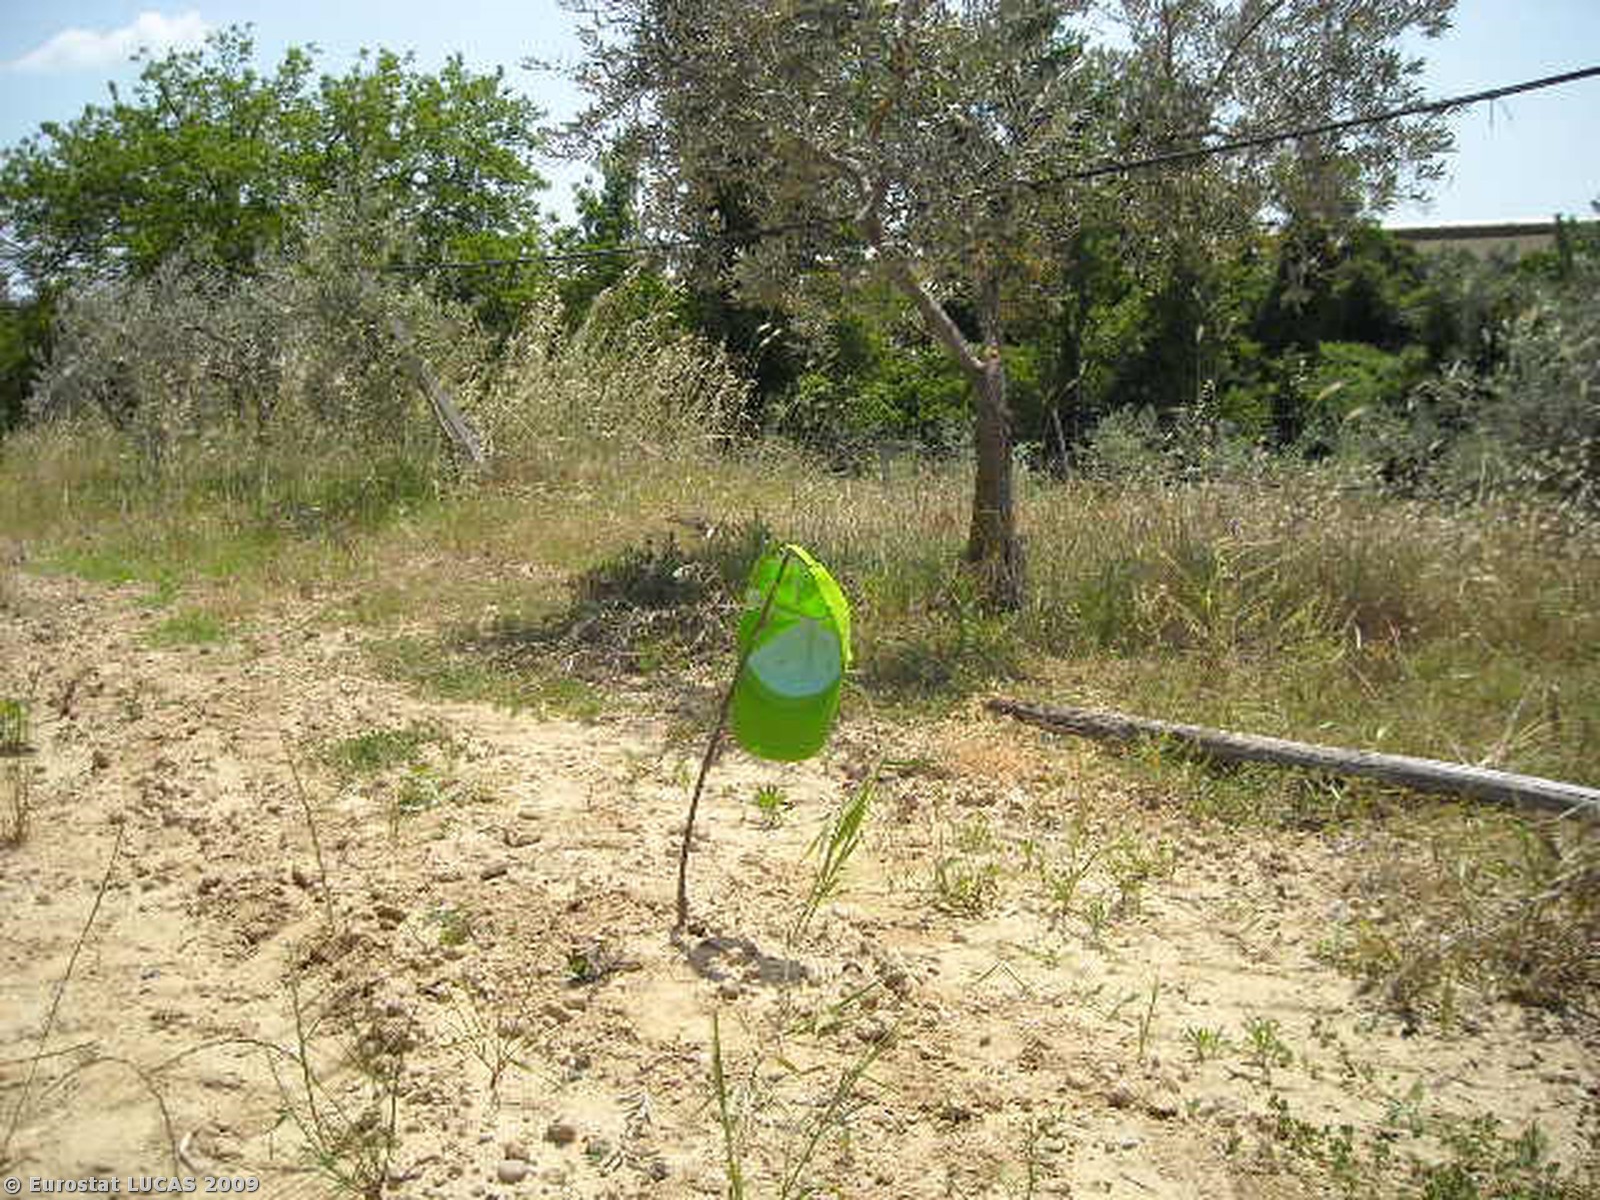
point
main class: Cropland
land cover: Vineyards
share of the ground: 25 - 50 %
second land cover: Bare land
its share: > 75 %
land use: Agriculture (excluding fallow land and kitchen gardens)
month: May
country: IT
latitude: 40.5305
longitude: 16.9291
